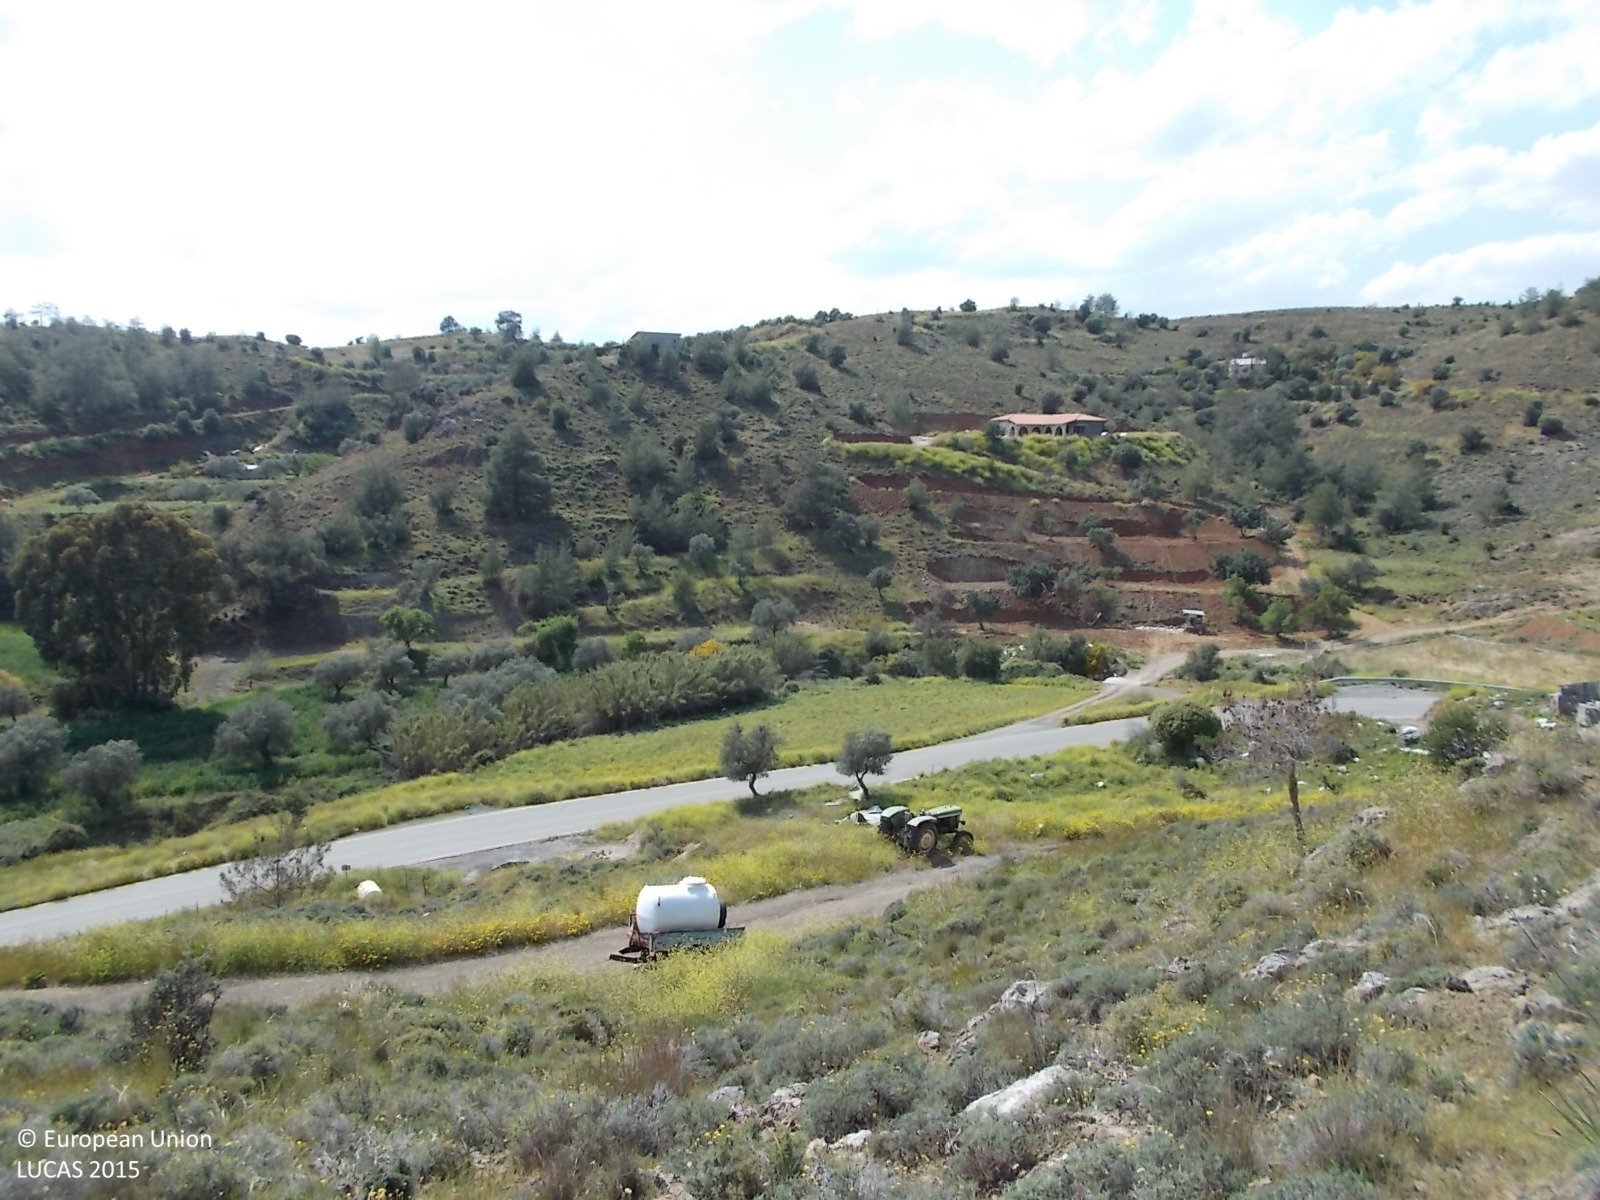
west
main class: Shrubland
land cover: Shrubland without tree cover
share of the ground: > 75 %
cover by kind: shrubs 75 %, herbaceous plants 15 %, unconsolidated bare surface 10 %
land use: Semi-natural and natural areas not in use
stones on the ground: 25 - 50 %
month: April
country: CY
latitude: 34.9562
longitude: 33.4616
